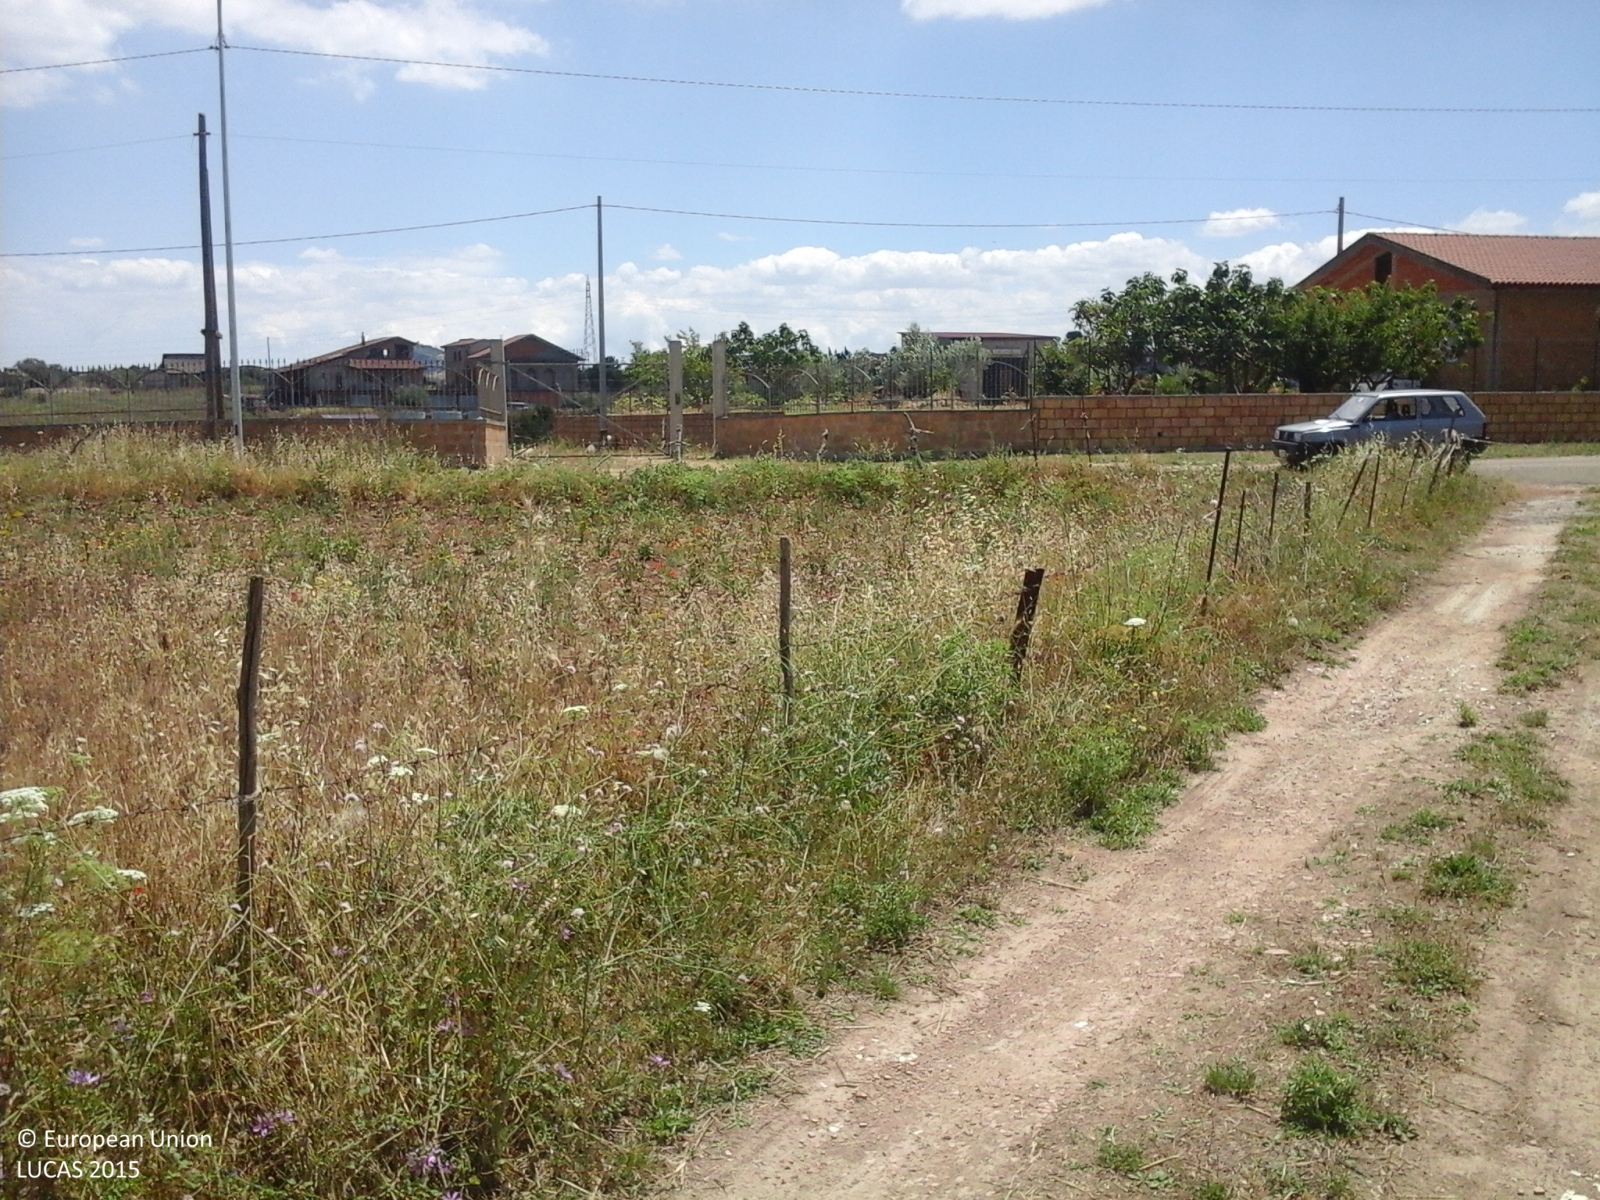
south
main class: Grassland
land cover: Spontaneously vegetated surfaces
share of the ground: > 75 %
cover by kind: herbaceous plants 90 %, unconsolidated bare surface 10 %
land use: Fallow land
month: June
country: IT
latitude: 37.6628
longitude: 14.4233
